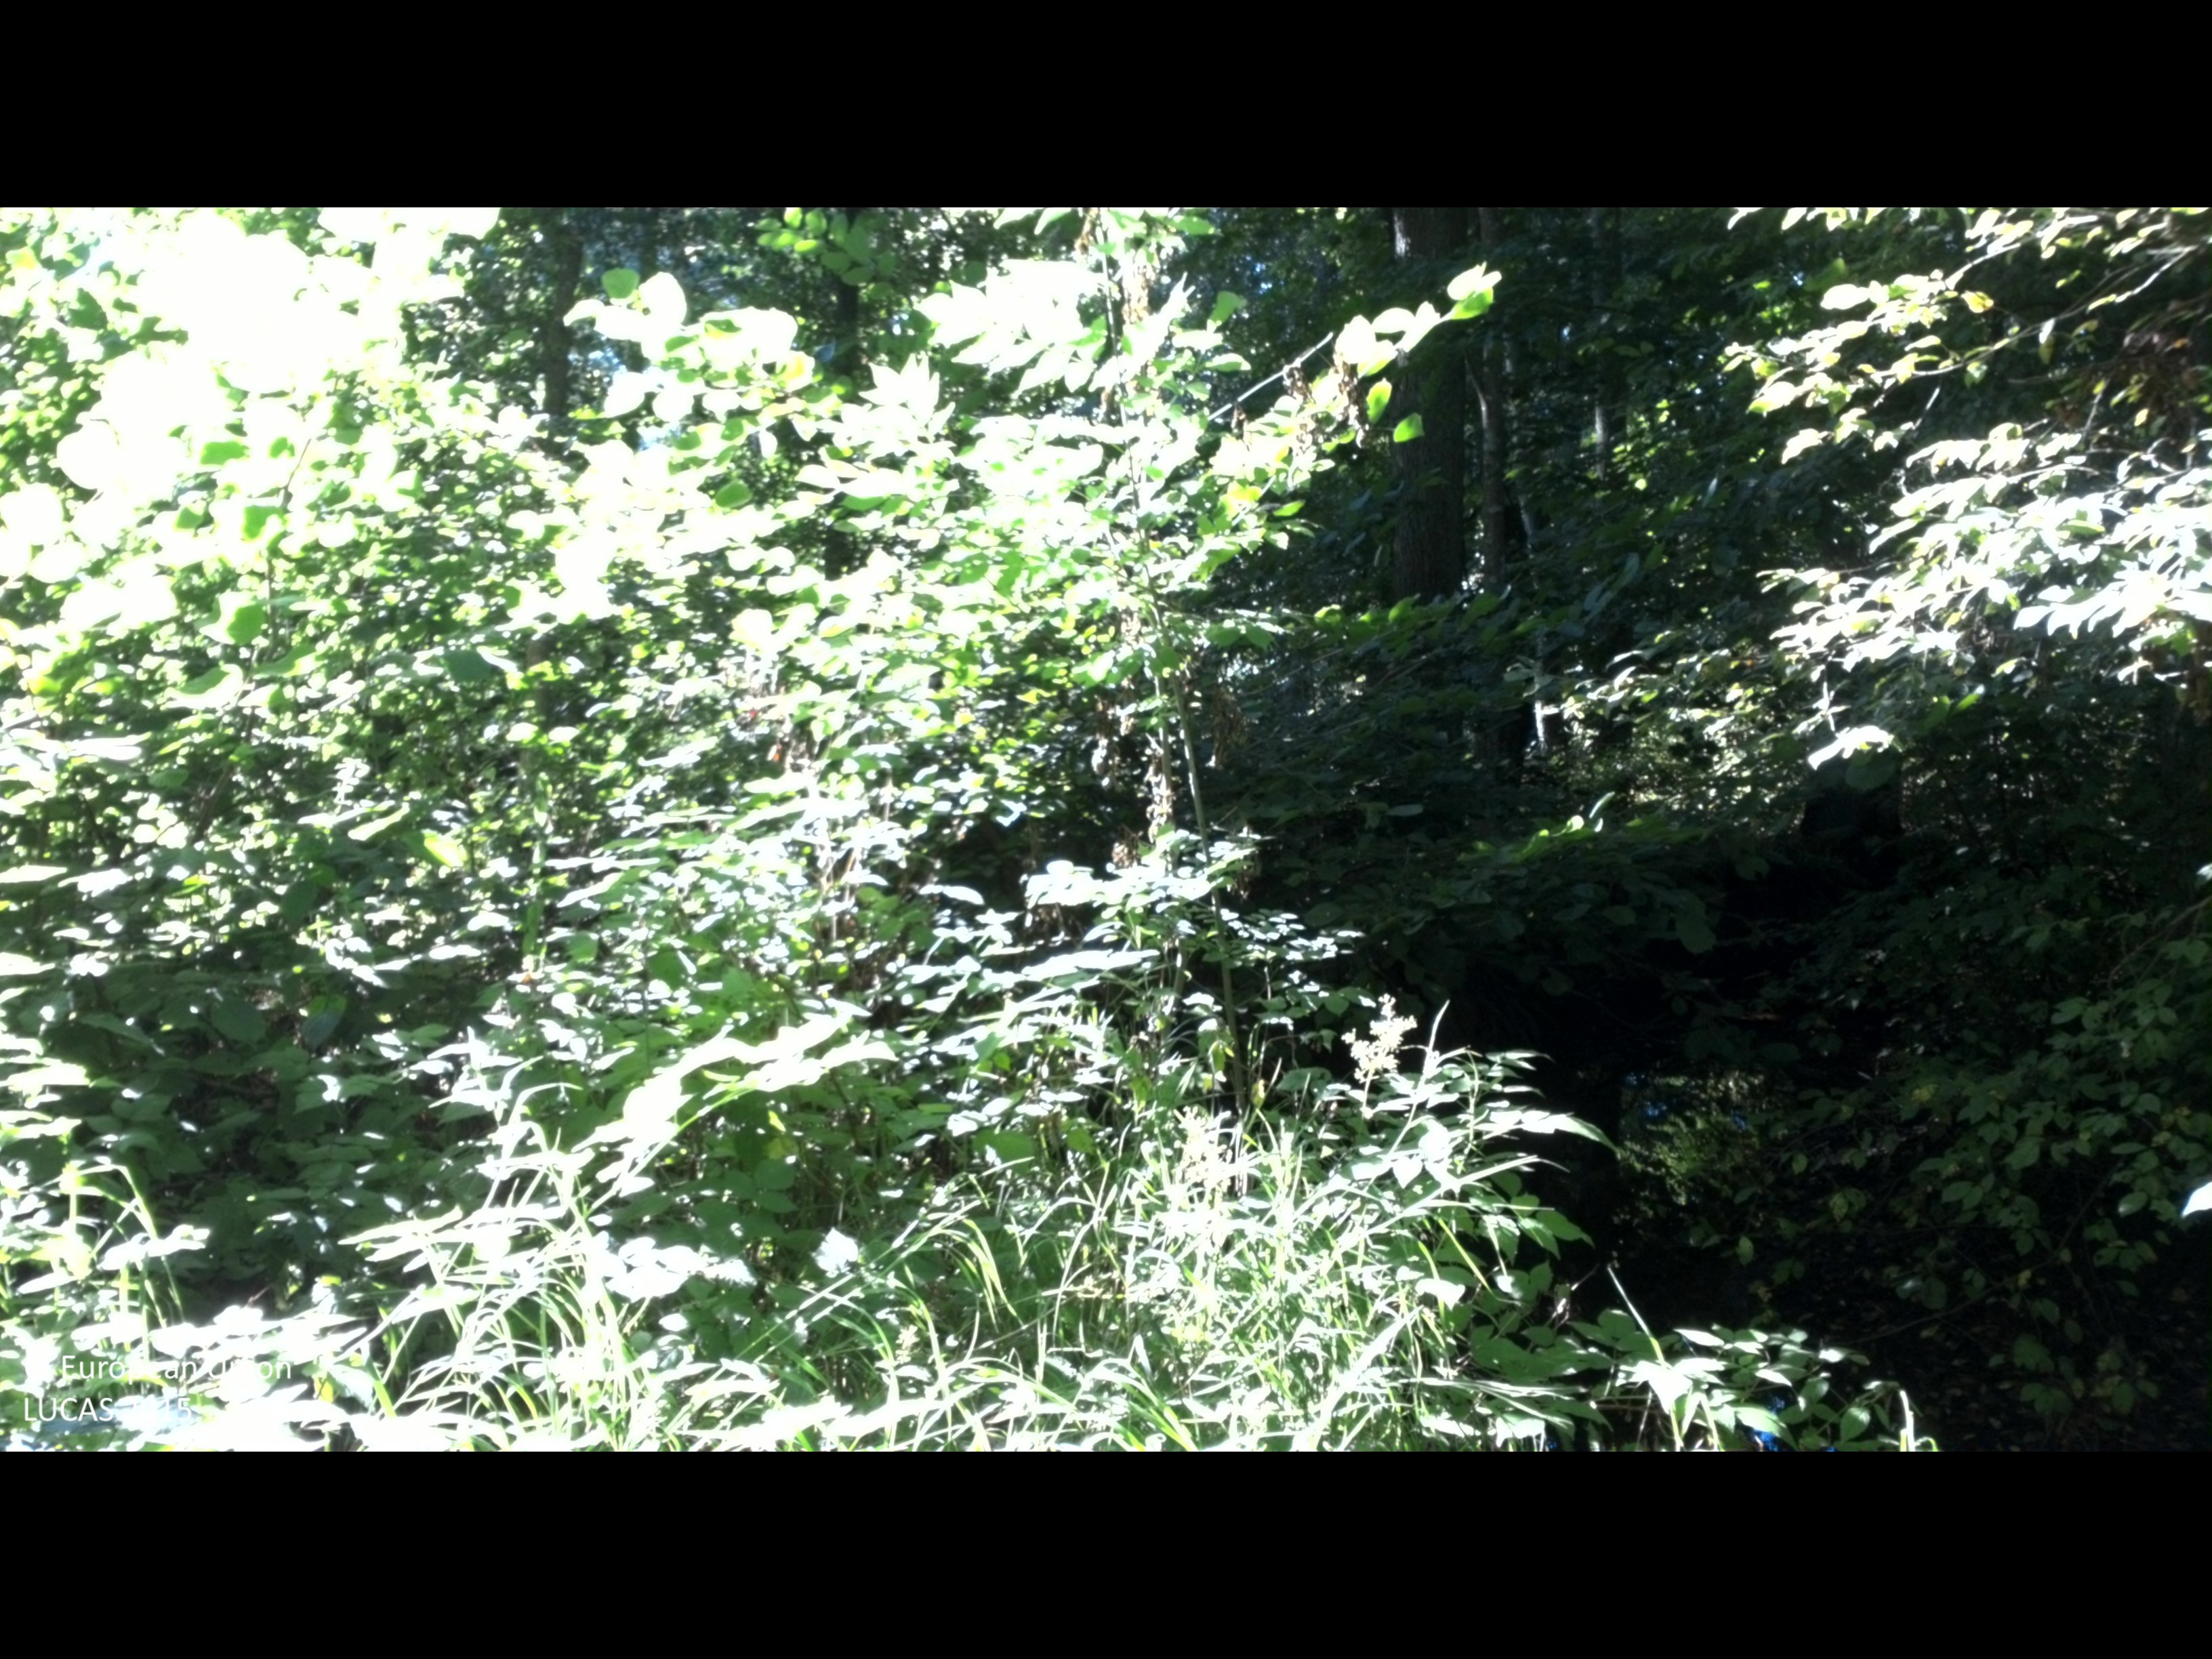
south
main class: Woodland
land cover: Broadleaved woodland
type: mire and swamp forests
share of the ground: 50 - 75 %
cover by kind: broadleaved forest trees 65 %, shrubs 25 %, herbaceous plants 10 %
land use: Forestry
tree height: > 5 m
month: September
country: SE
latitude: 56.1856
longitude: 14.3643
